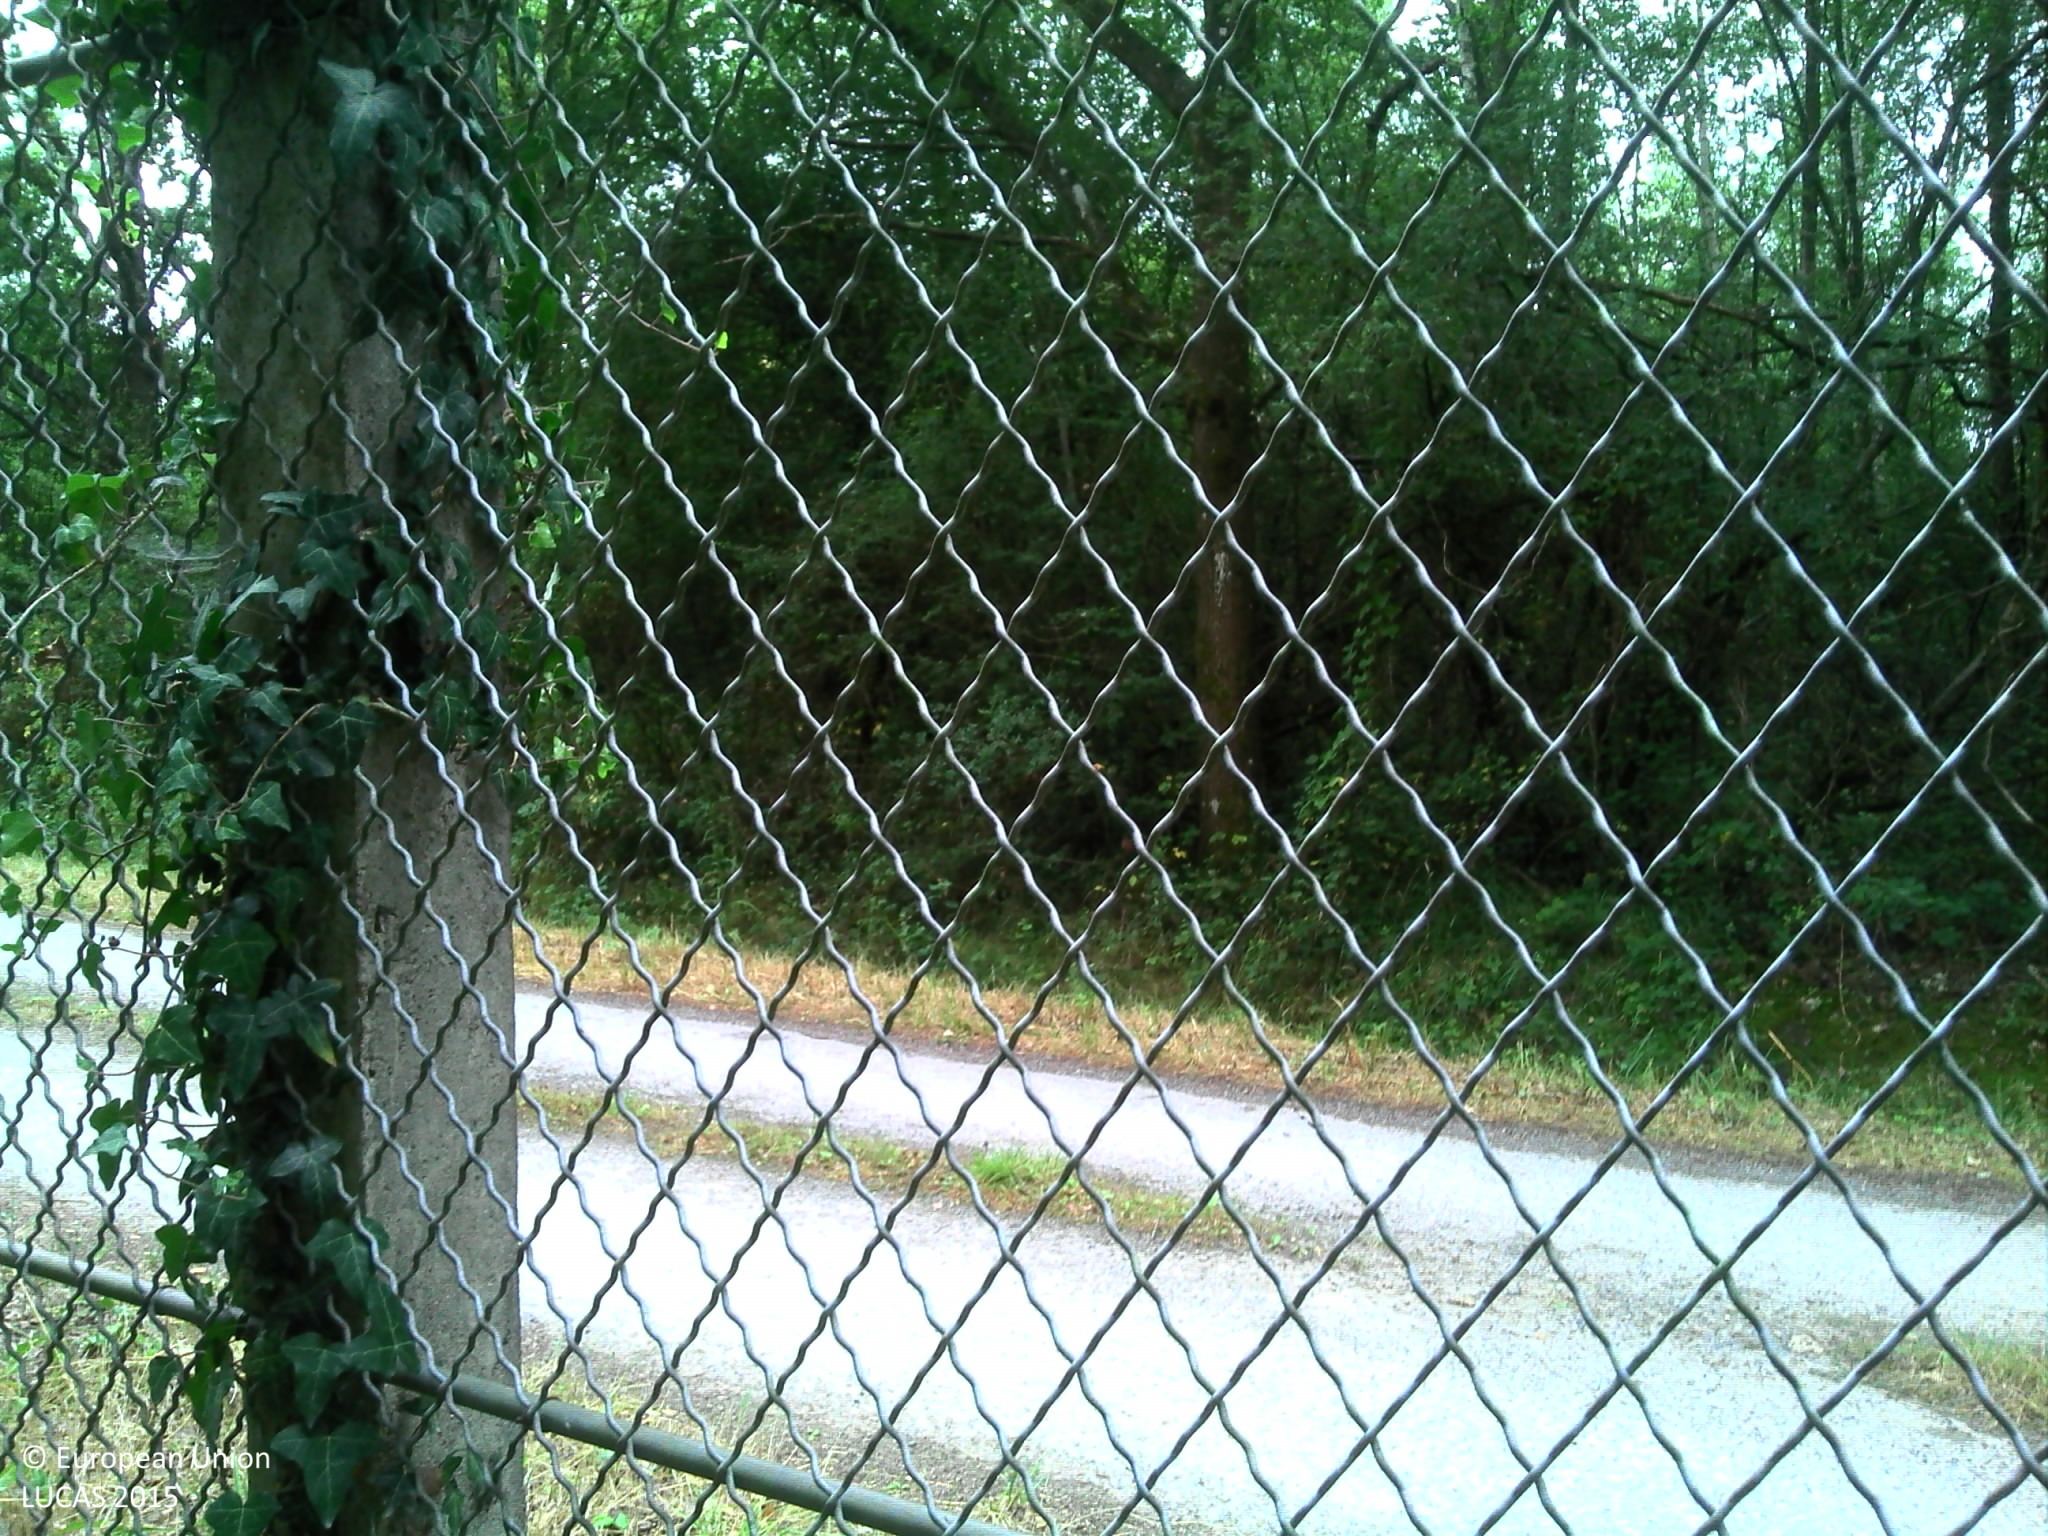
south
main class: Woodland
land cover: Broadleaved woodland
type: acidophilous oak and oak-birch forest
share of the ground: > 75 %
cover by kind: broadleaved forest trees 65 %, lichens and mosses 15 %, herbaceous plants 10 %, consolidated bare surface 5 %, unconsolidated bare surface 5 %
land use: Community services
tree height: > 5 m
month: July
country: FR
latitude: 48.5515
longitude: 2.5792
